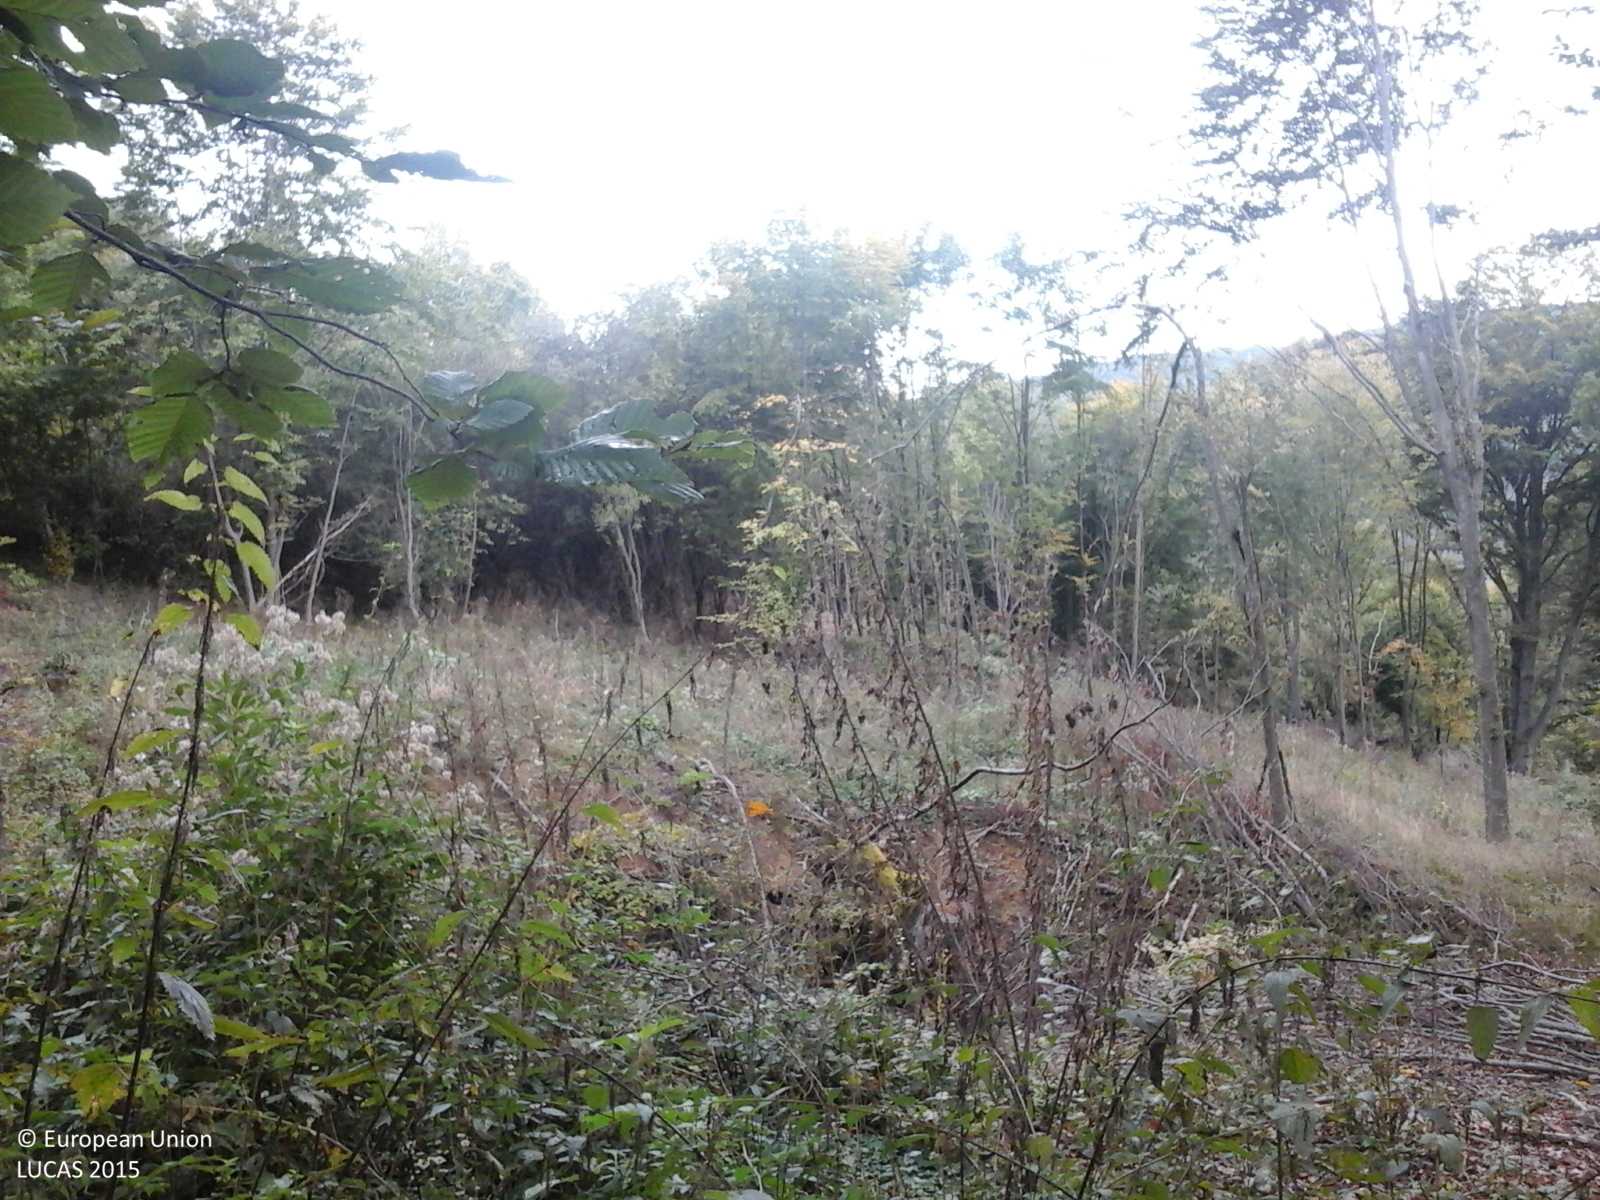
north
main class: Woodland
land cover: Broadleaved woodland
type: beech forest
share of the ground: > 75 %
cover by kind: broadleaved forest trees 100 %
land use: Forestry
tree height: > 5 m
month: October
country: RO
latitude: 46.3901
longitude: 24.9594
